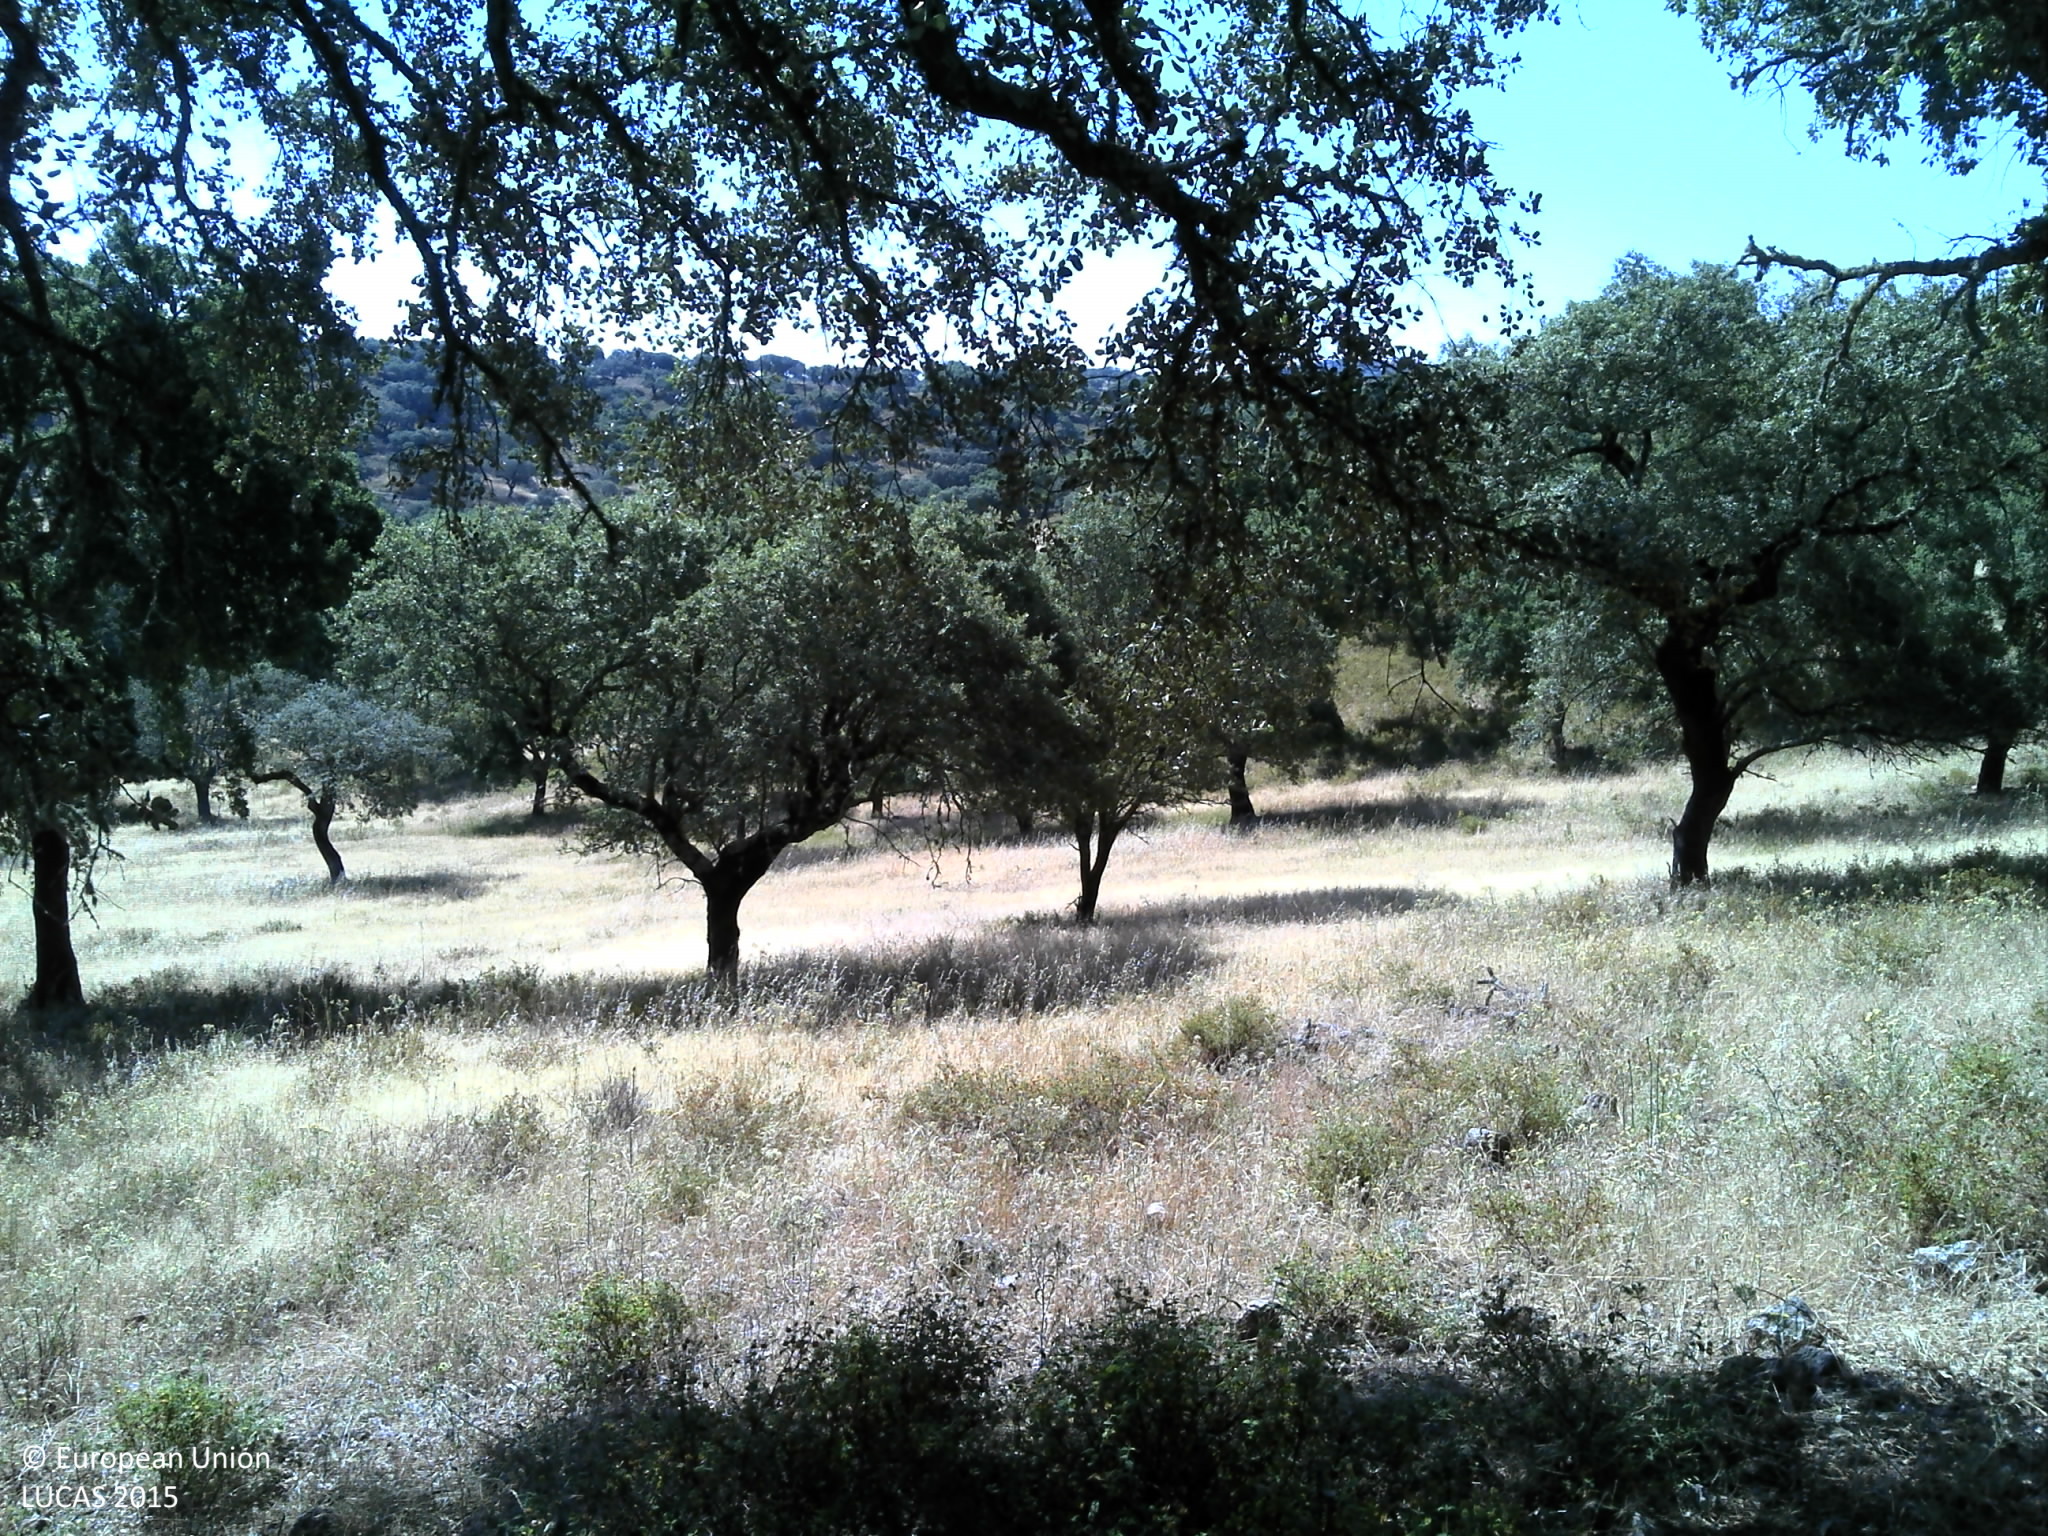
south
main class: Woodland
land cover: Broadleaved woodland
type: broadleaved evergreen forest
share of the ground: 50 - 75 %
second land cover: Grassland without tree/shrub cover
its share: 25 - 50 %
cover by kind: broadleaved forest trees 50 %, herbaceous plants 40 %, unconsolidated bare surface 10 %
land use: Forestry
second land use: Agriculture (excluding fallow land and kitchen gardens)
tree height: > 5 m
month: June
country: PT
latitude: 38.7790
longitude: -8.1564
